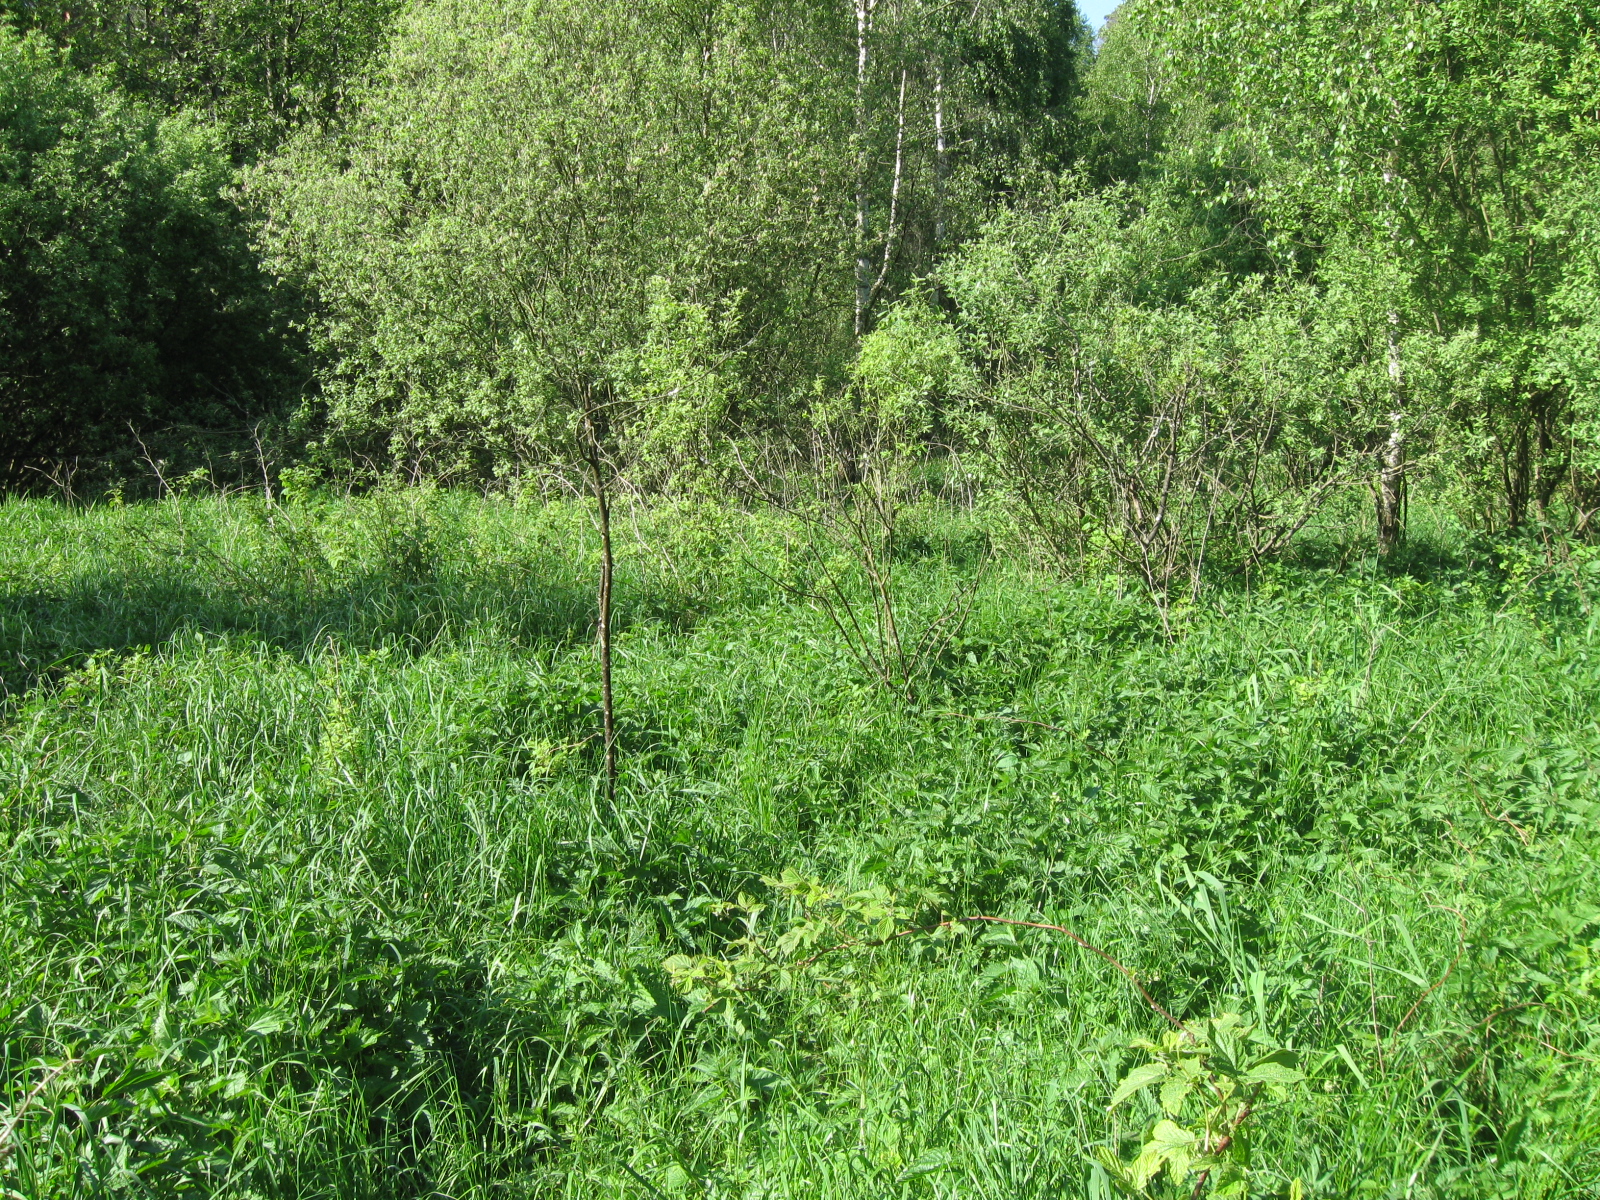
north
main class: Shrubland
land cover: Shrubland with sparse tree cover
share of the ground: > 75 %
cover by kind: herbaceous plants 50 %, shrubs 45 %, broadleaved forest trees 5 %
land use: Forestry
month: June
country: LT
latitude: 54.1410
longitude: 23.6323
